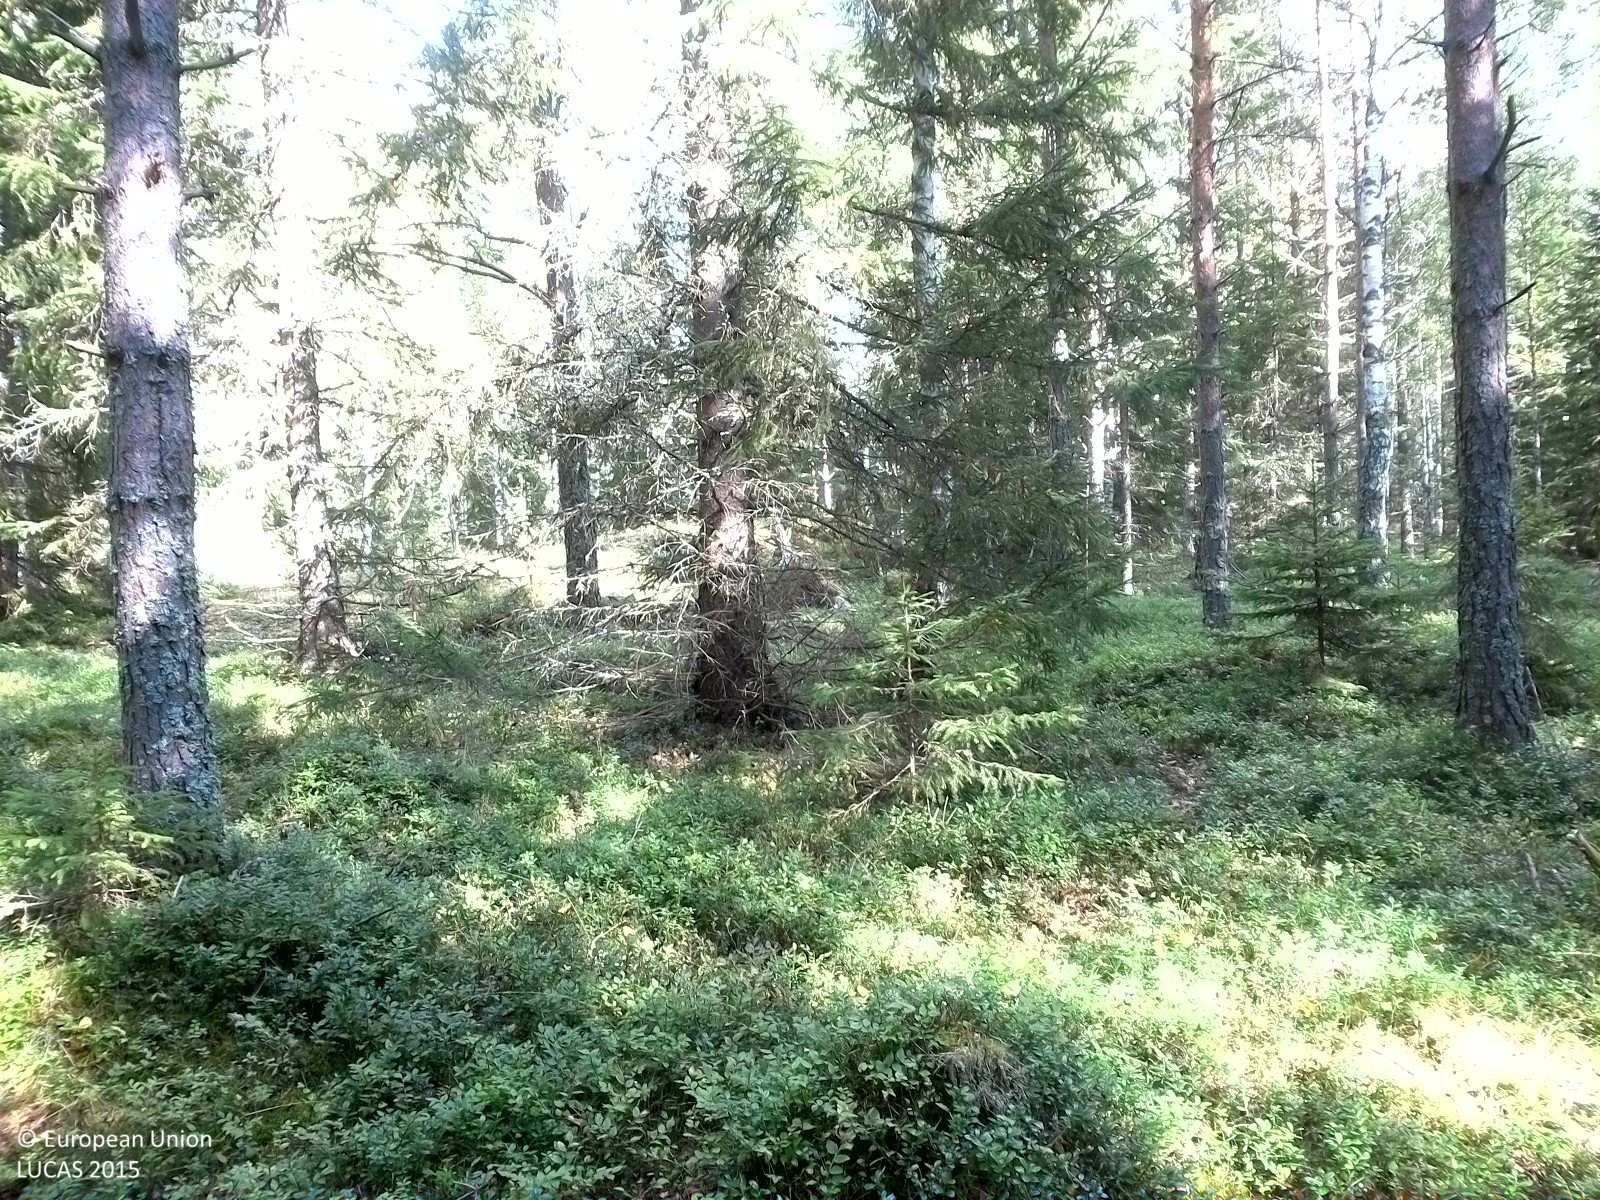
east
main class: Woodland
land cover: Other mixed woodland
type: boreal forest
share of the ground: 25 - 50 %
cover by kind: herbaceous plants 40 %, coniferous forest trees 30 %, broadleaved forest trees 15 %, lichens and mosses 15 %
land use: Forestry
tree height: > 5 m
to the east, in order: Other mixed woodland; Ditches and canals; Spruce dominated mixed woodland; Tracks; Spruce dominated mixed woodland; Tracks; Spruce dominated mixed woodland
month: August
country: SE
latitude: 59.0235
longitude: 15.5843
